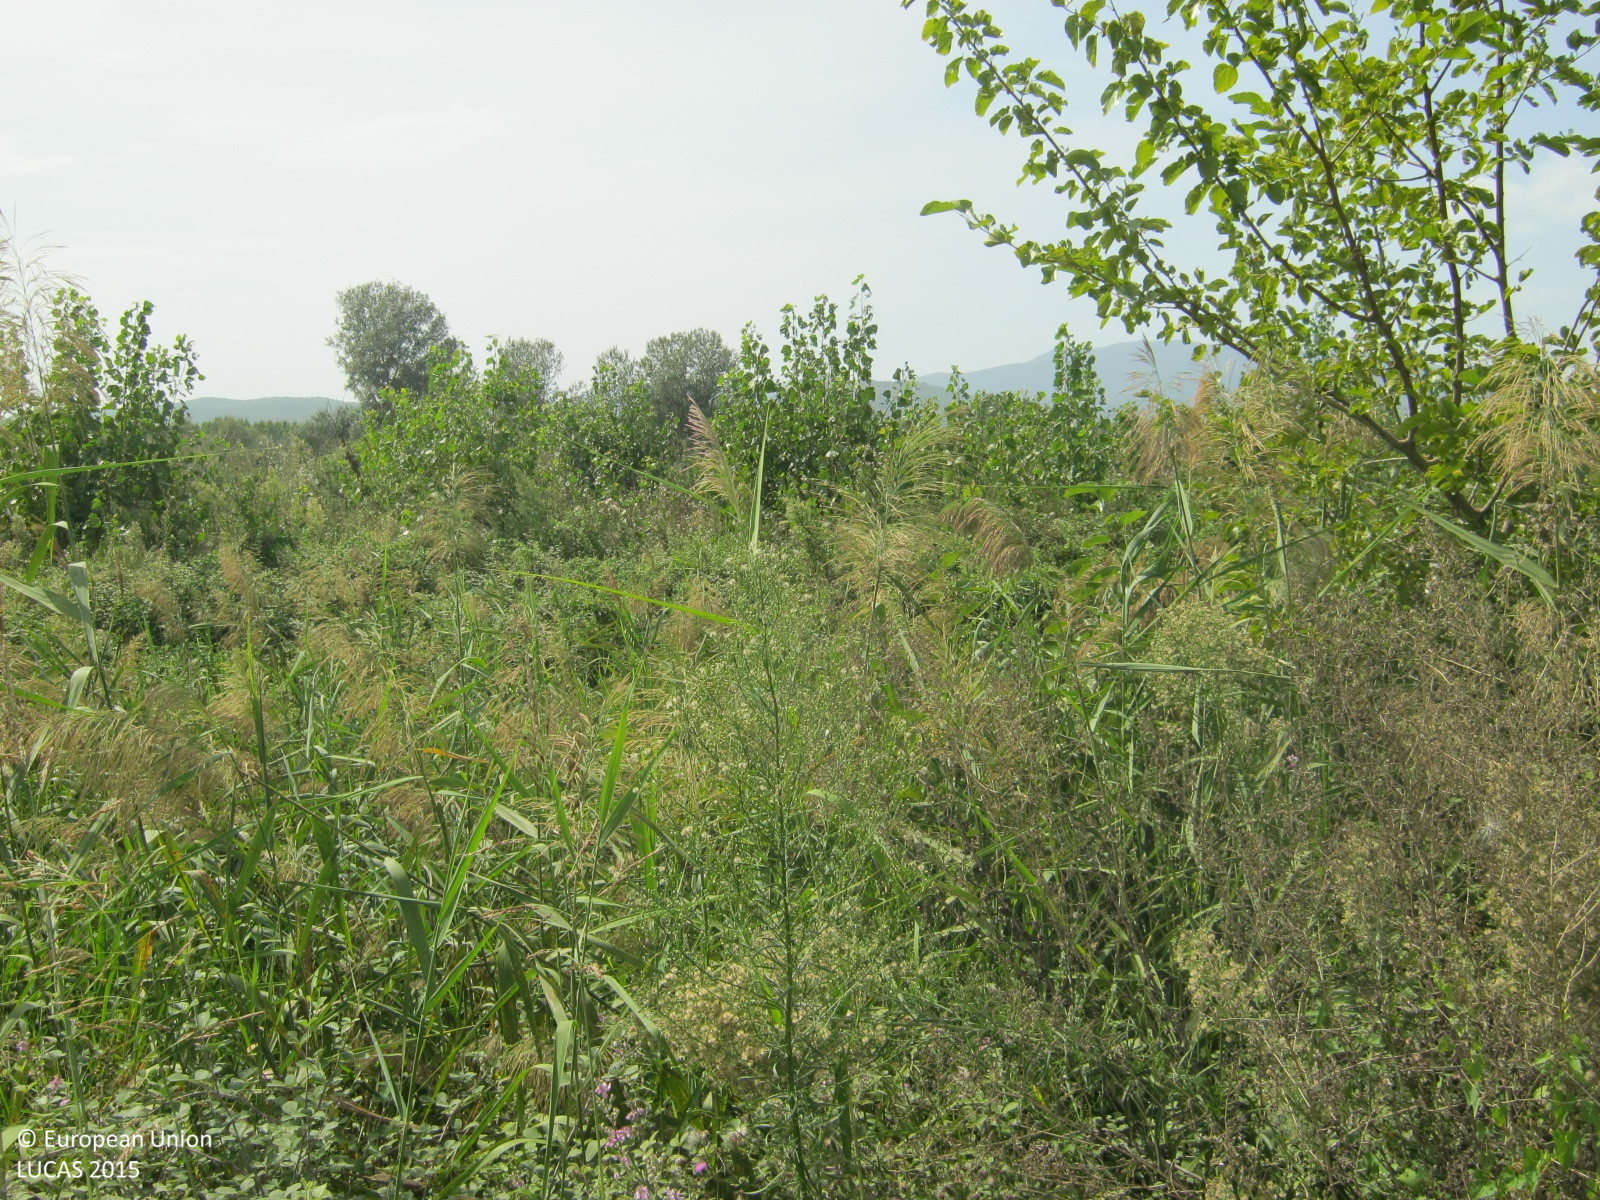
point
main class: Woodland
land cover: Broadleaved woodland
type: floodplain forest
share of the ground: 50 - 75 %
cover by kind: broadleaved forest trees 70 %, herbaceous plants 20 %, shrubs 10 %
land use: Forestry
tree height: < 5 m
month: September
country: GR
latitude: 41.0971
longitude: 23.2919
